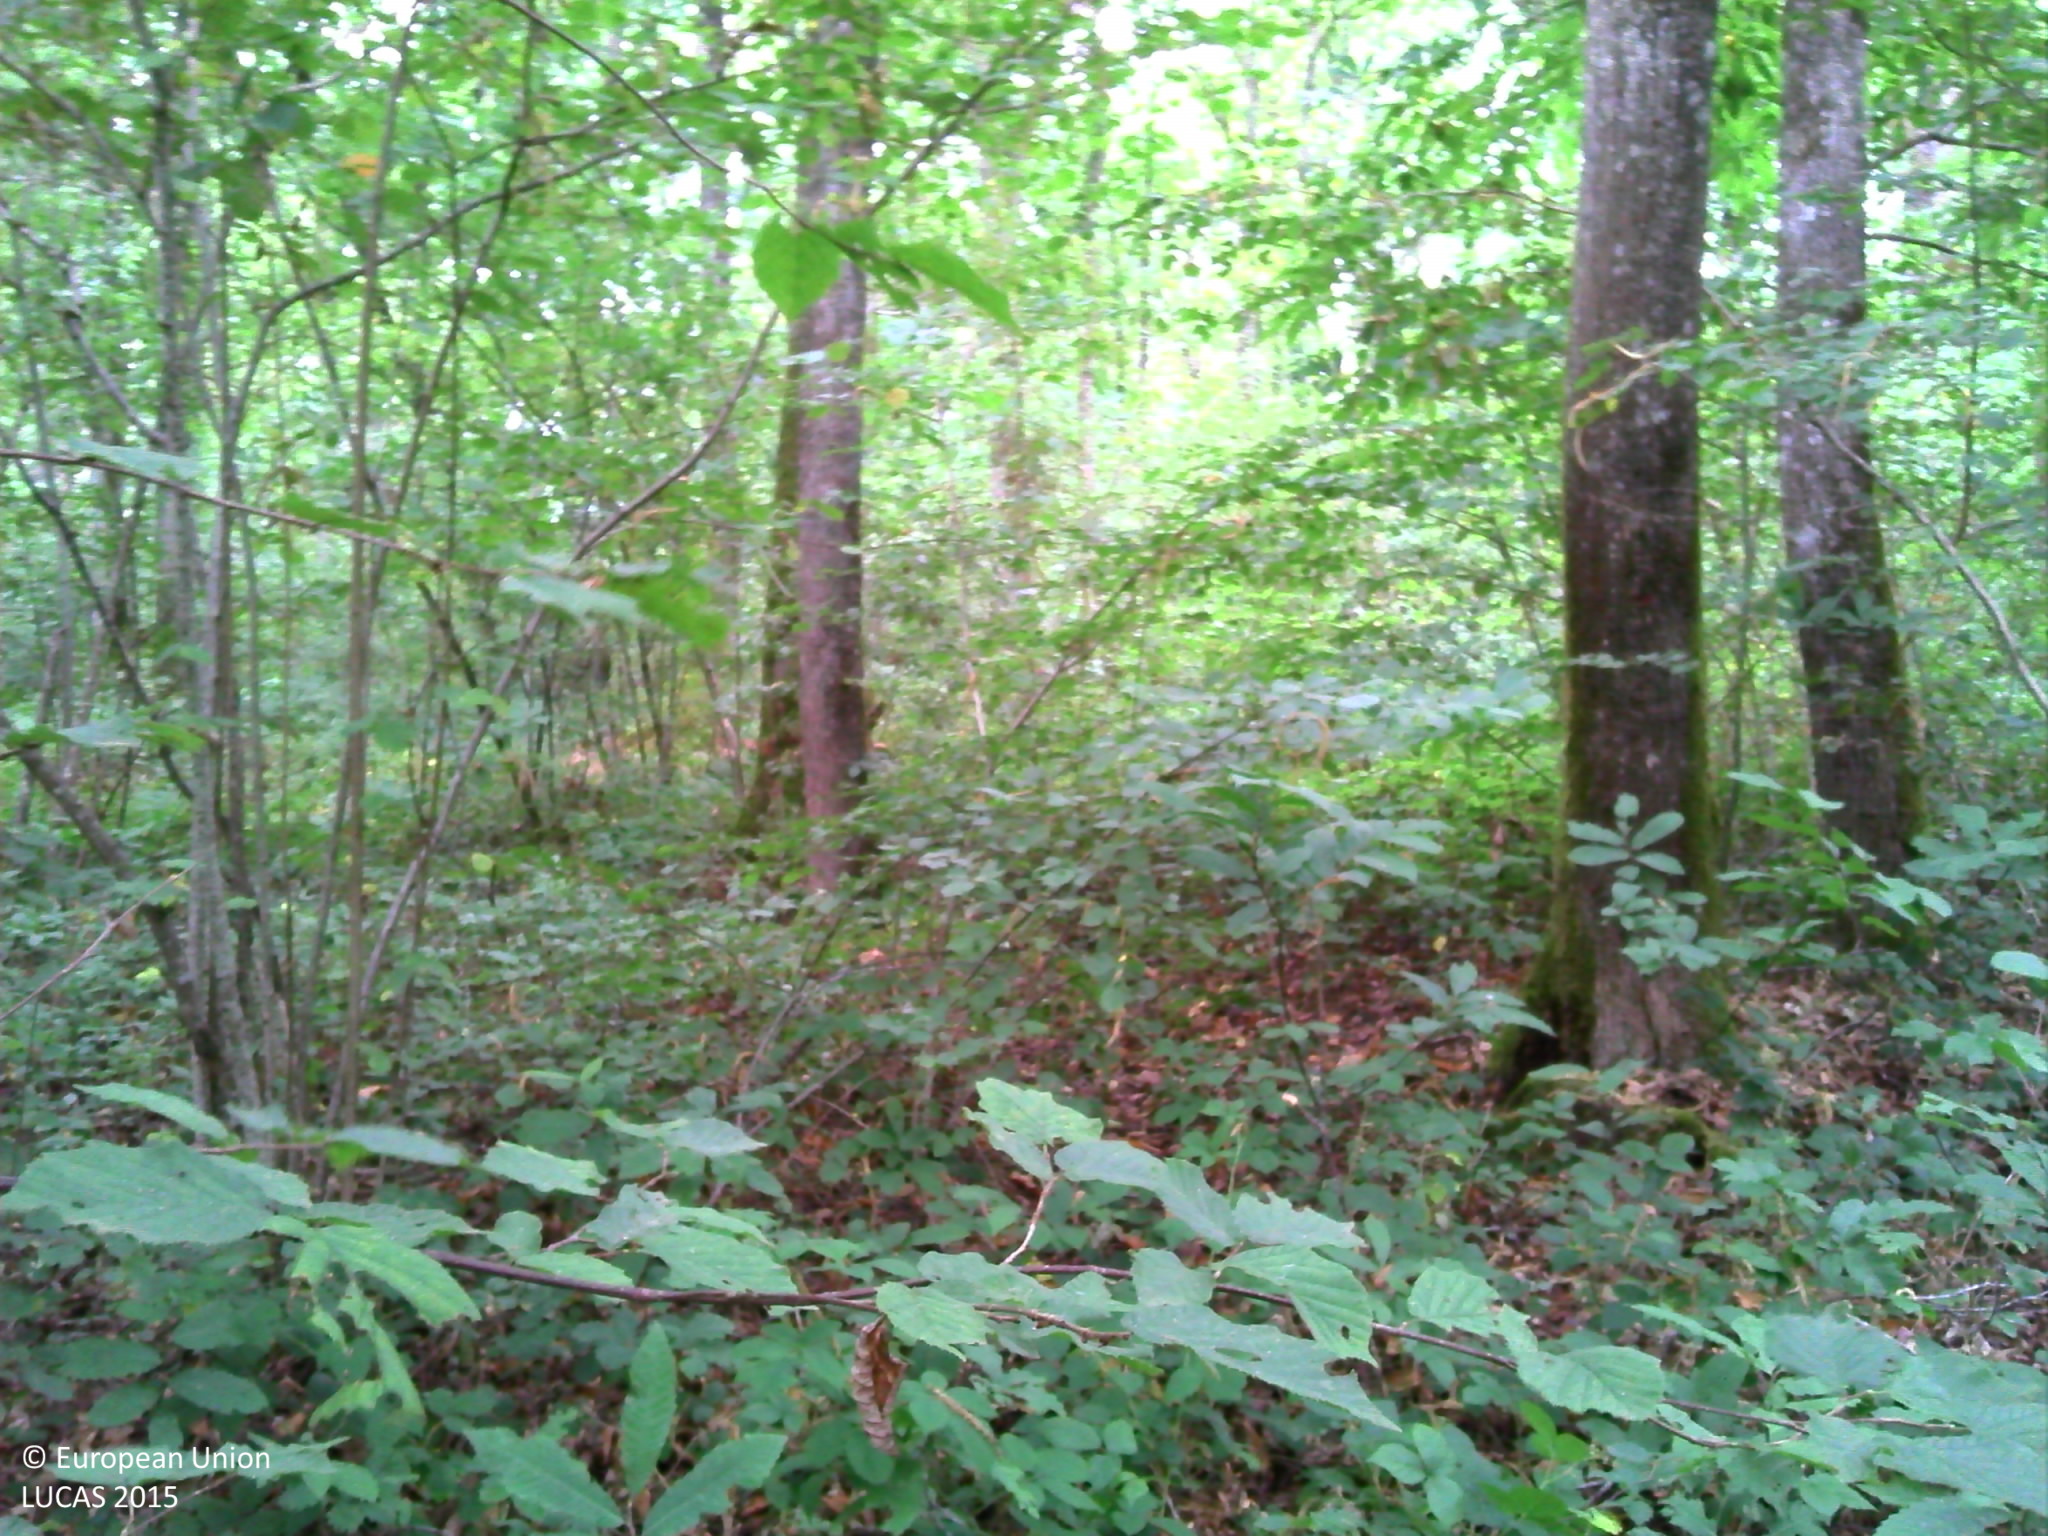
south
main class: Woodland
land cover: Broadleaved woodland
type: mesophytic deciduous forest
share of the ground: > 75 %
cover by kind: broadleaved forest trees 90 %, herbaceous plants 5 %, lichens and mosses 5 %
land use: Forestry
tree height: > 5 m
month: July
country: FR
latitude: 48.1354
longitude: 3.4233
